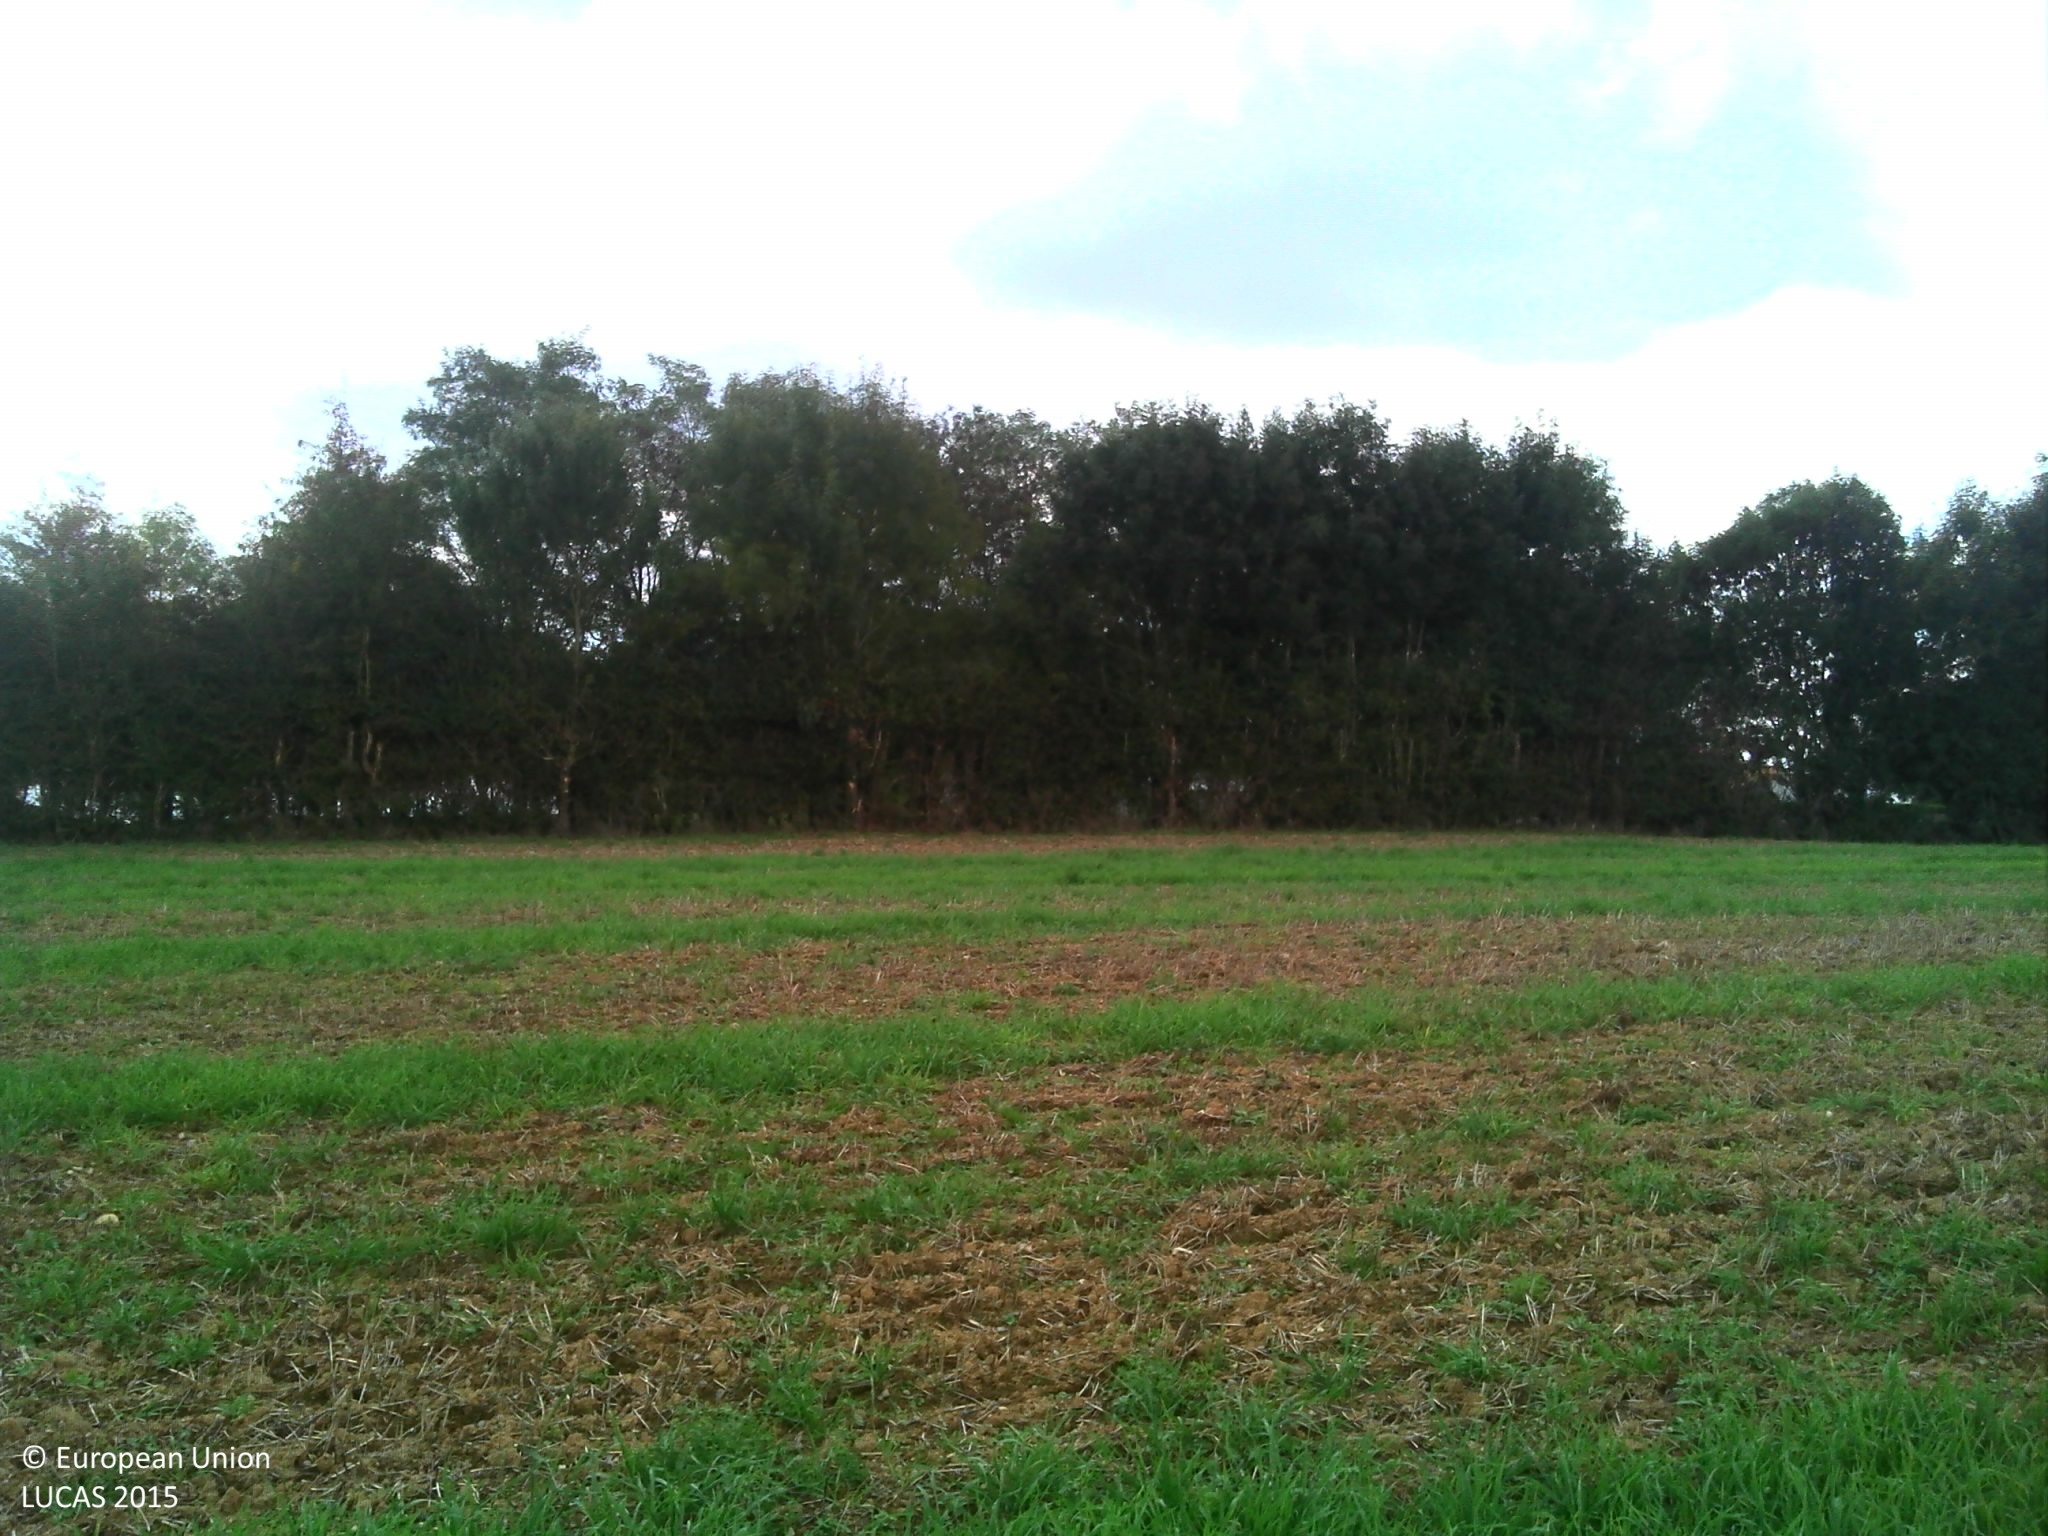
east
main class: Cropland
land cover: Temporary grasslands
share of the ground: > 75 %
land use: Agriculture (excluding fallow land and kitchen gardens)
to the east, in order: Temporary grasslands; Managed hedges; Broadleaved woodland; Artificial constructions in urban areas; Broadleaved woodland; Grass margins; Tracks; Grass margins; Temporary grasslands
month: October
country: FR
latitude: 47.2244
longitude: -0.9299
